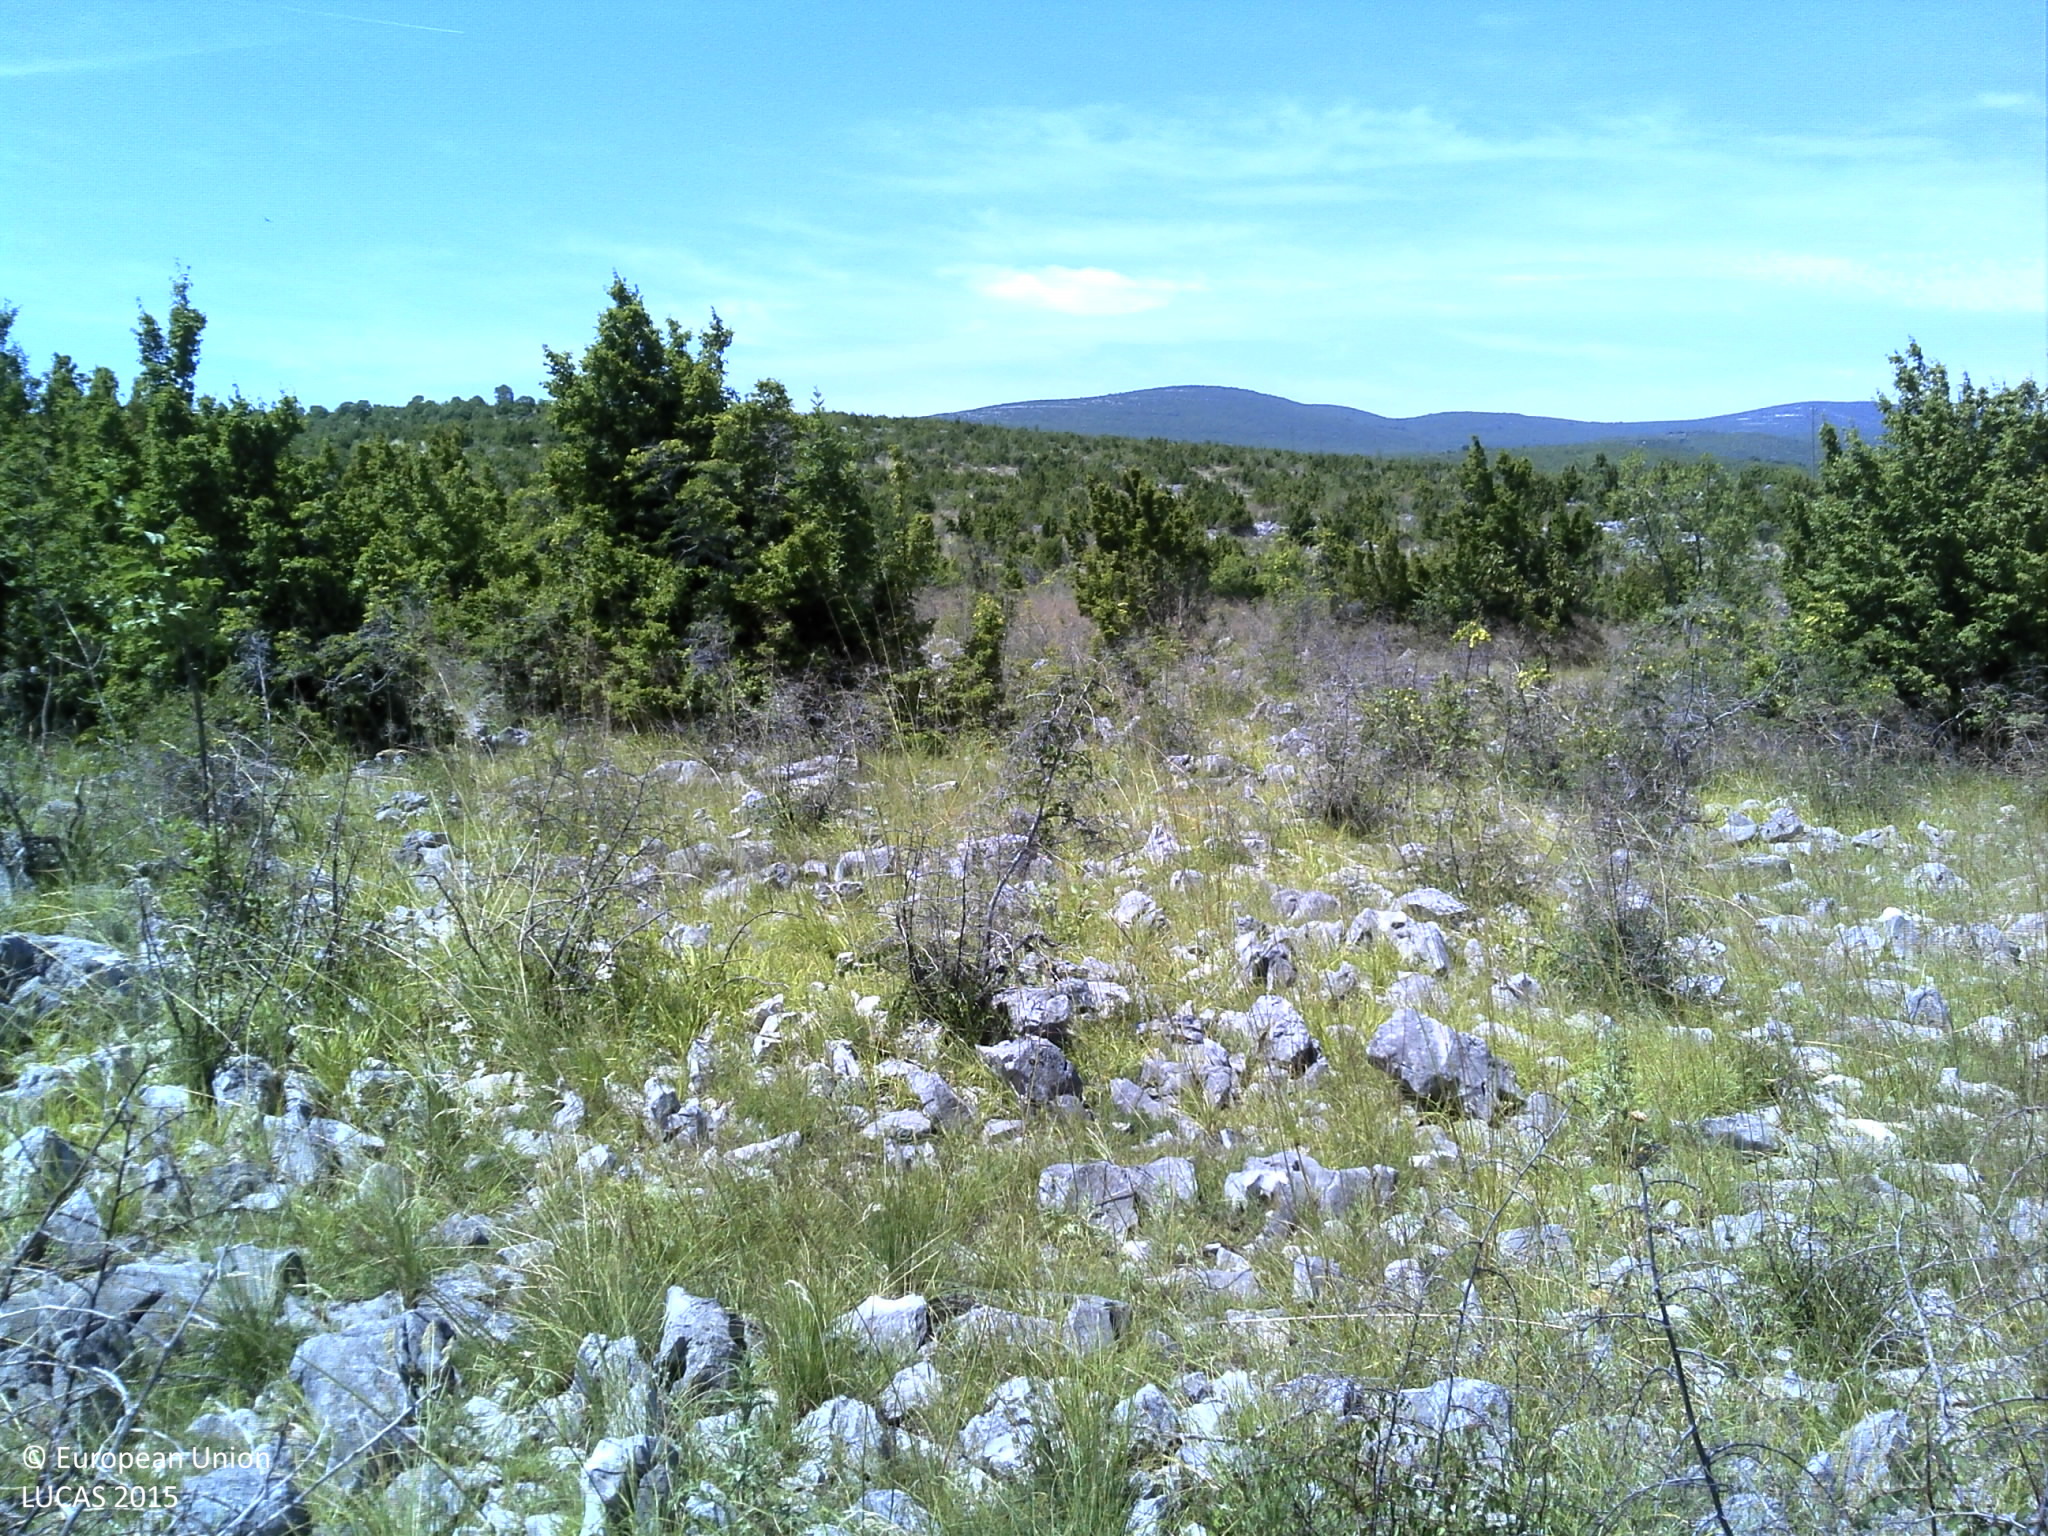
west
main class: Shrubland
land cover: Shrubland with sparse tree cover
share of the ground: 50 - 75 %
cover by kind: shrubs 35 %, unconsolidated bare surface 30 %, herbaceous plants 20 %, consolidated bare surface 10 %, broadleaved forest trees 5 %
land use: Semi-natural and natural areas not in use
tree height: < 5 m
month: June
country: HR
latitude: 44.0894
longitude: 15.9499
